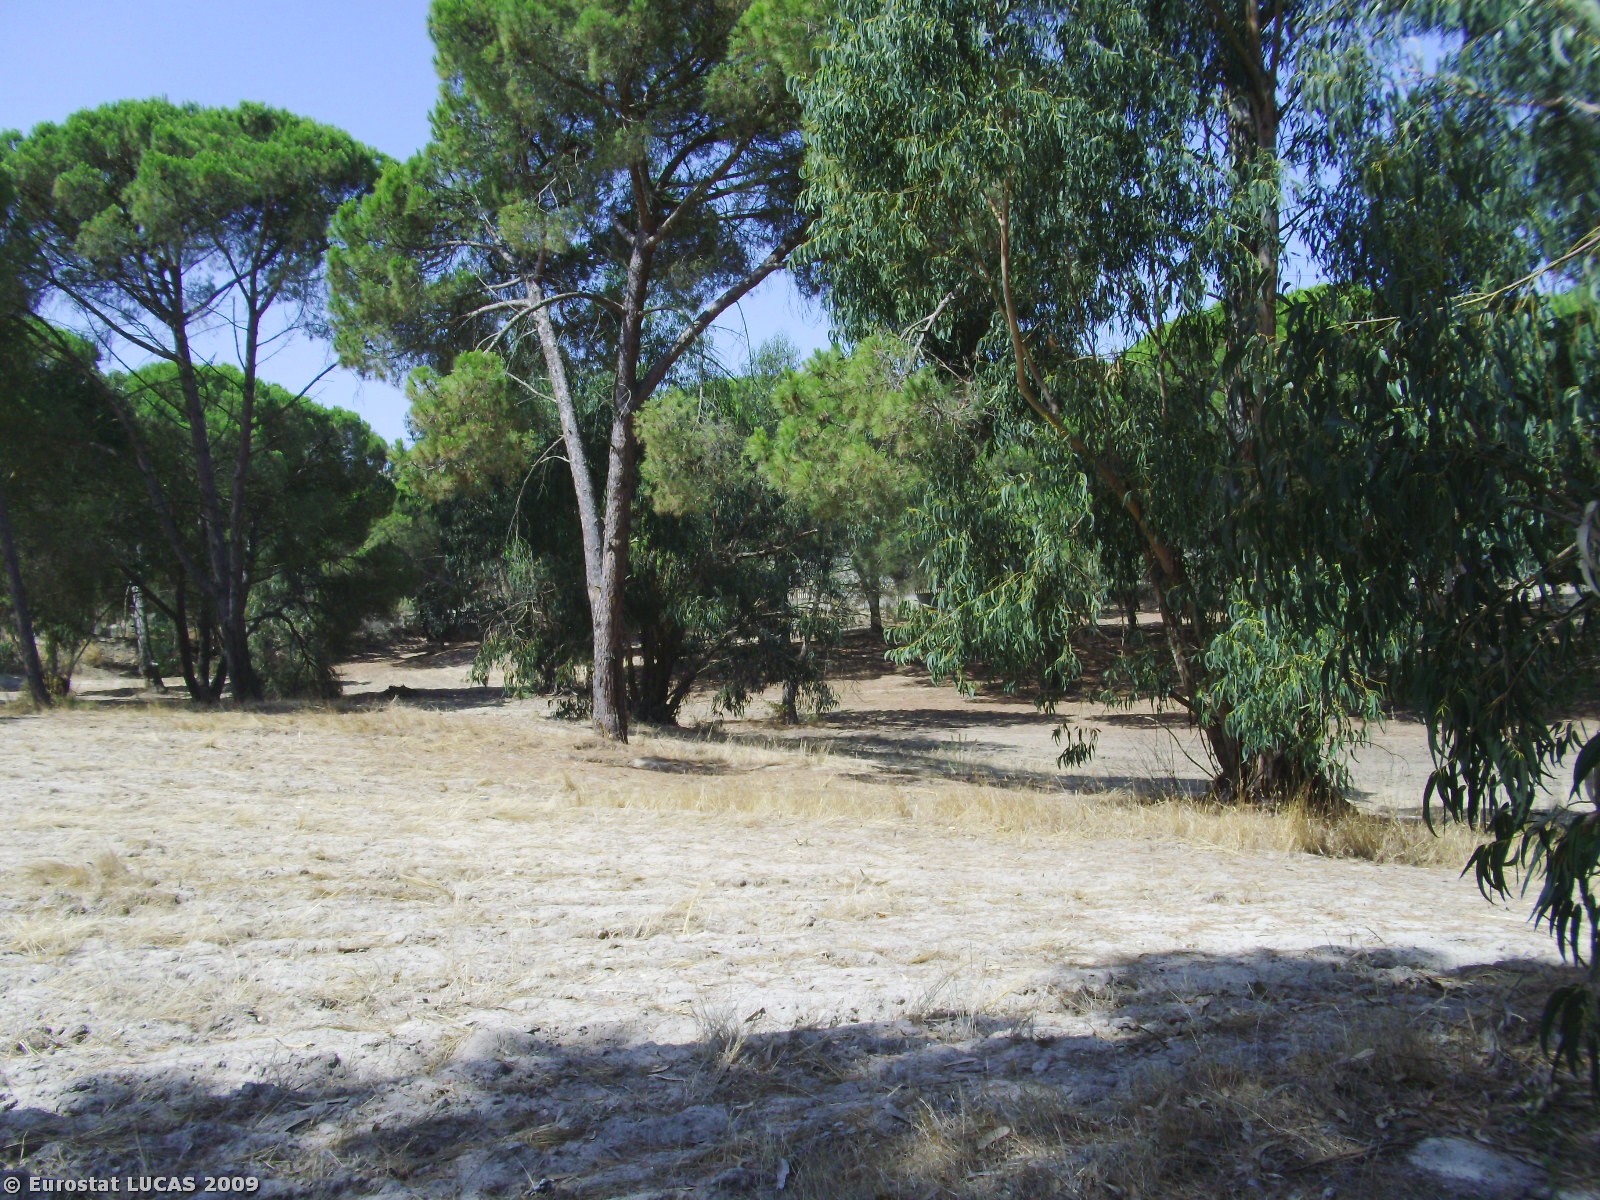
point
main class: Woodland
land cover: Broadleaved woodland
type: plantations and self-sown exotic forest
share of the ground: 25 - 50 %
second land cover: Bare land
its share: 50 - 75 %
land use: Forestry
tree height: > 5 m
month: July
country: PT
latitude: 38.5034
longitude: -8.8099
